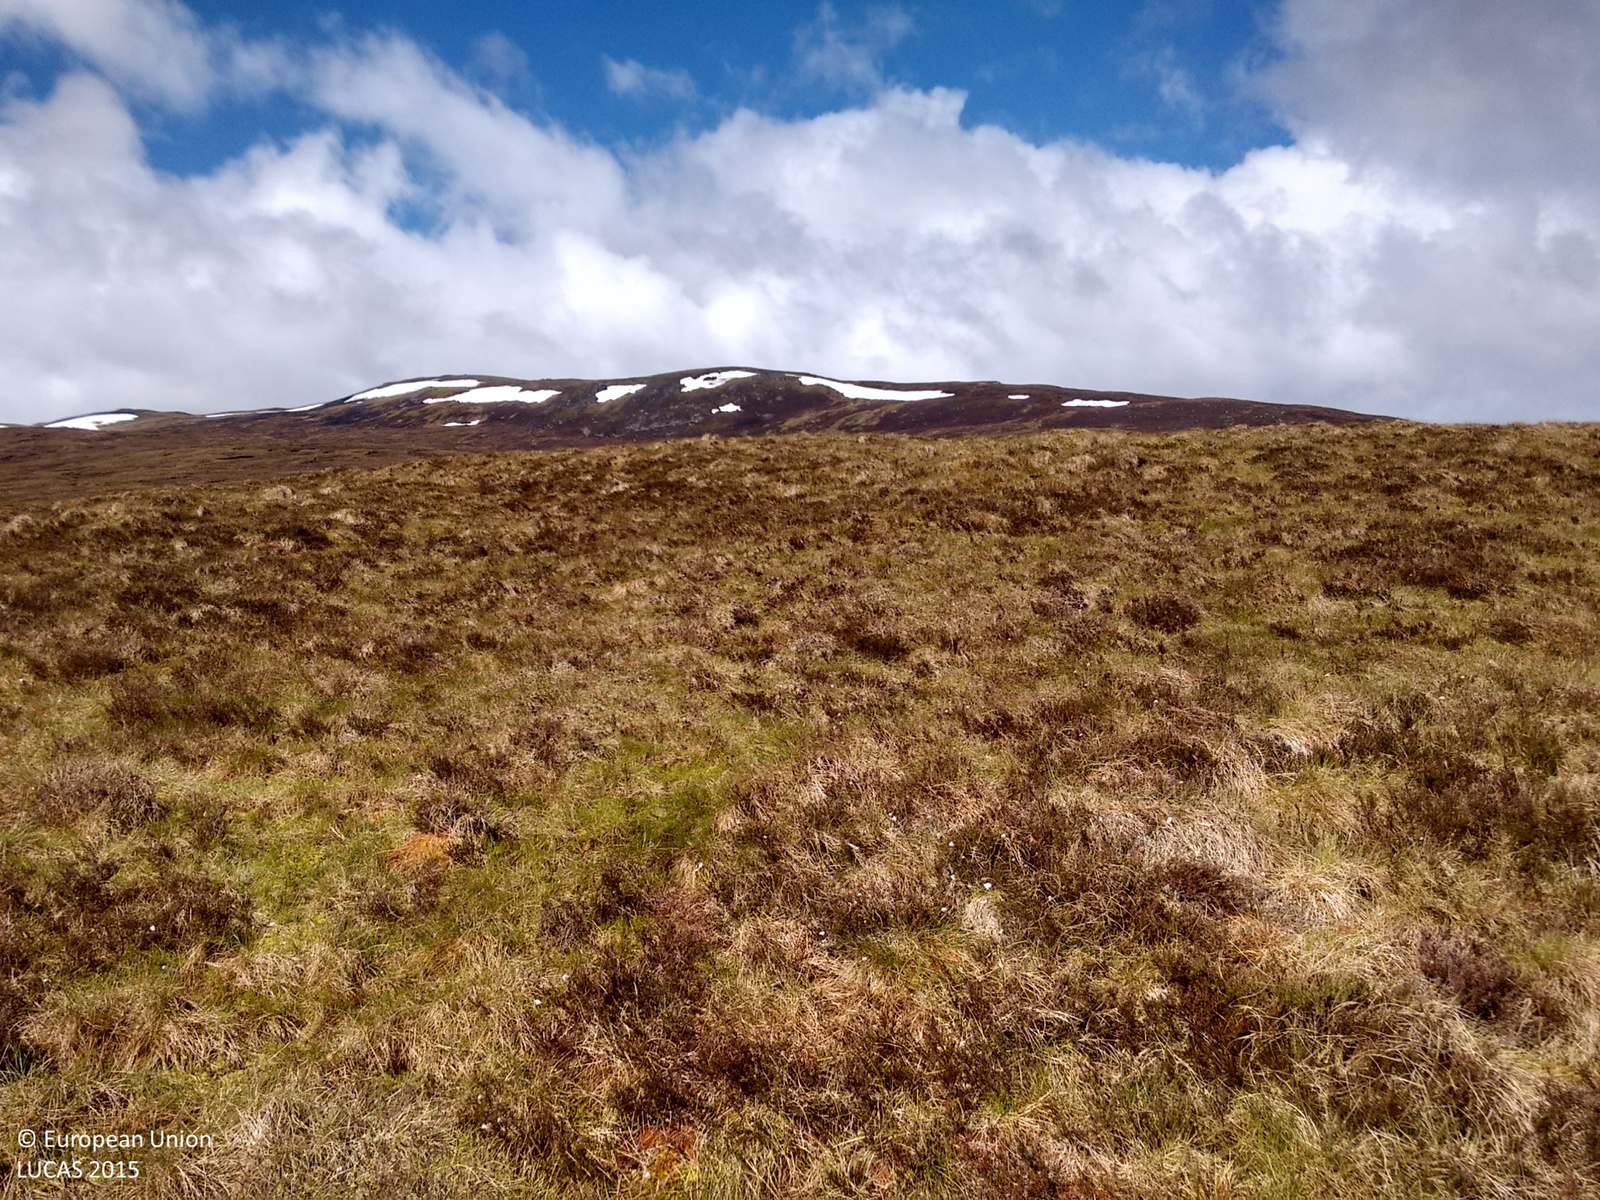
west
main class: Shrubland
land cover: Shrubland without tree cover
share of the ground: > 75 %
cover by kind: shrubs 50 %, herbaceous plants 40 %, lichens and mosses 10 %
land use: Agriculture (excluding fallow land and kitchen gardens)
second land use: Other primary production
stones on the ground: < 10 %
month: June
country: GB
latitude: 56.9394
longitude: -4.2732
